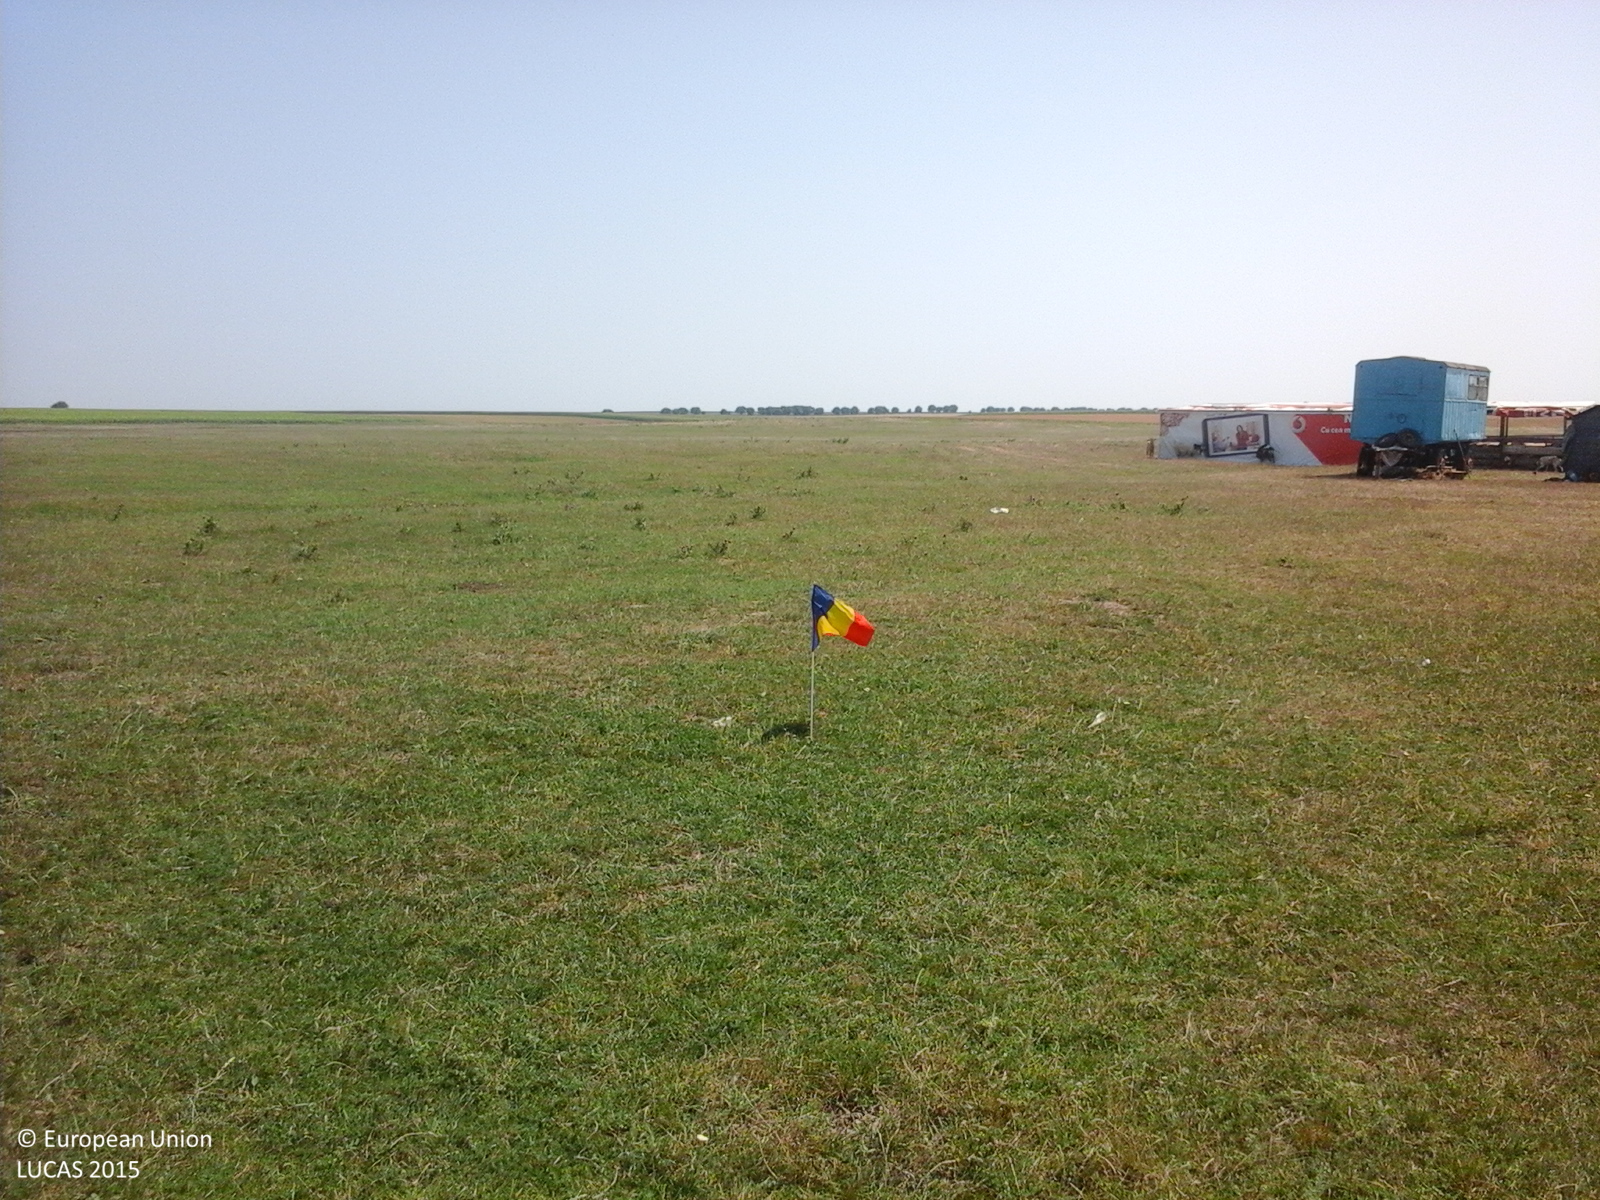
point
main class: Grassland
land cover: Grassland without tree/shrub cover
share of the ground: > 75 %
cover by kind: herbaceous plants 100 %
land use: Agriculture (excluding fallow land and kitchen gardens)
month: July
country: RO
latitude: 44.7369
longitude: 27.1197
